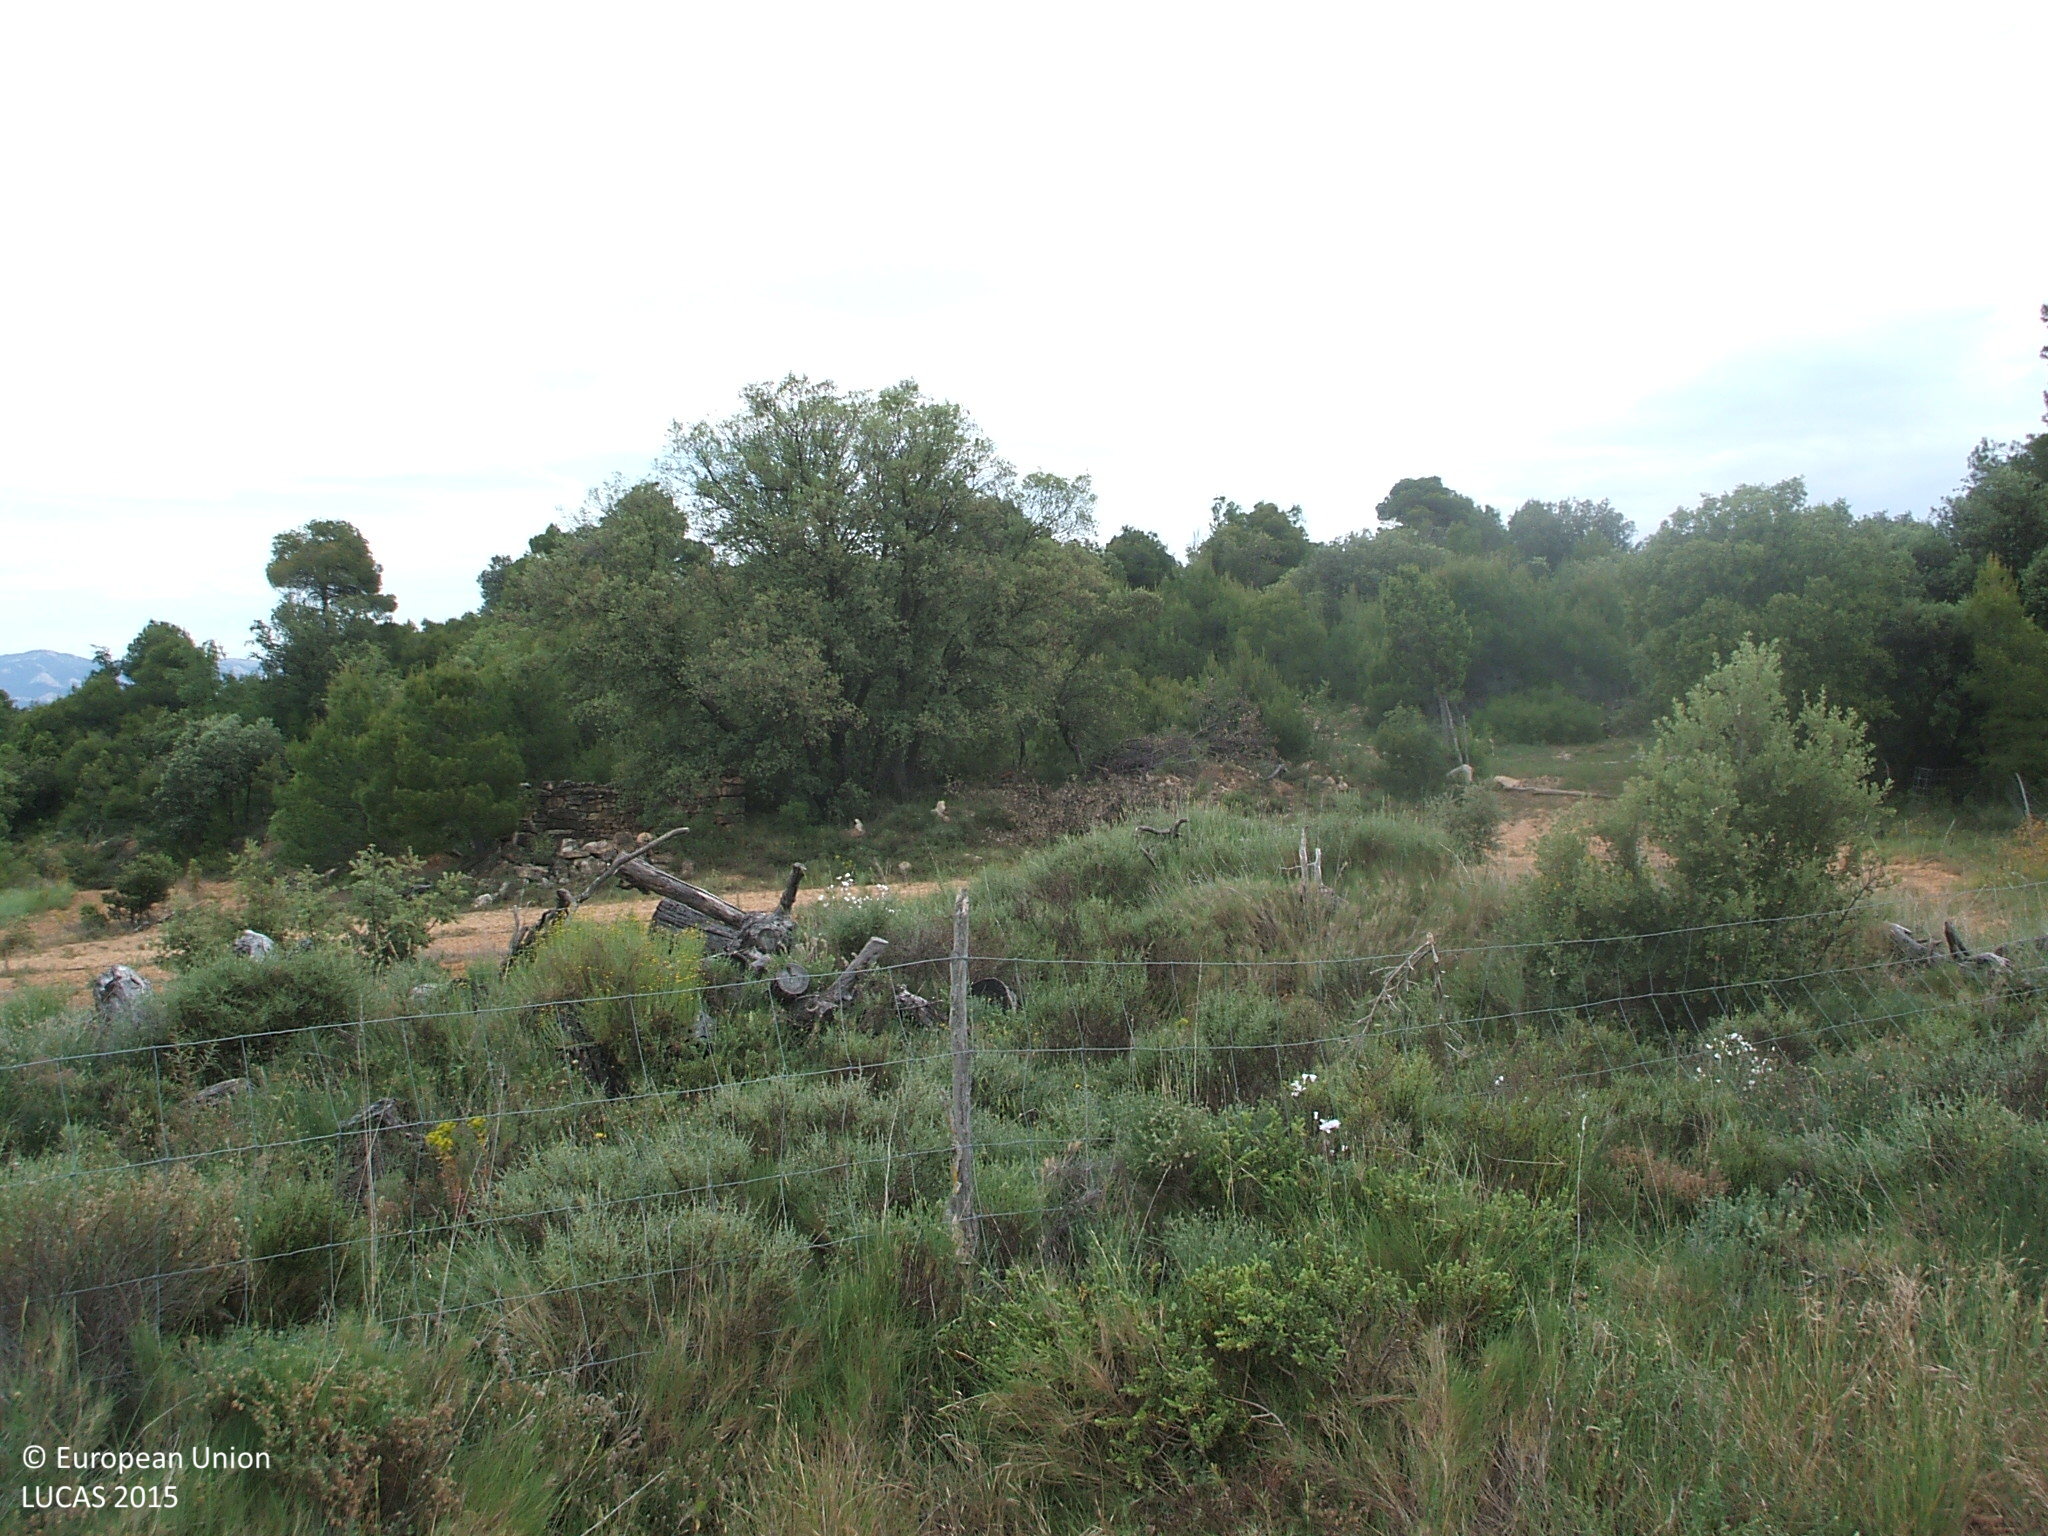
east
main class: Cropland
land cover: Other fresh vegetables
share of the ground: 10 - 25 %
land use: Agriculture (excluding fallow land and kitchen gardens)
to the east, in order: Other fresh vegetables; Dry stone walls; Shruby margins; Other fresh vegetables; Fences; Broadleaved woodland; Pine dominated mixed woodland; Dry stone walls; Olive groves; Dry stone walls; Olive groves; Dry stone walls; Olive groves; Dry stone walls; Olive groves; Dry stone walls; Olive groves; Broadleaved woodland
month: June
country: ES
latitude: 40.7731
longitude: -0.0198
